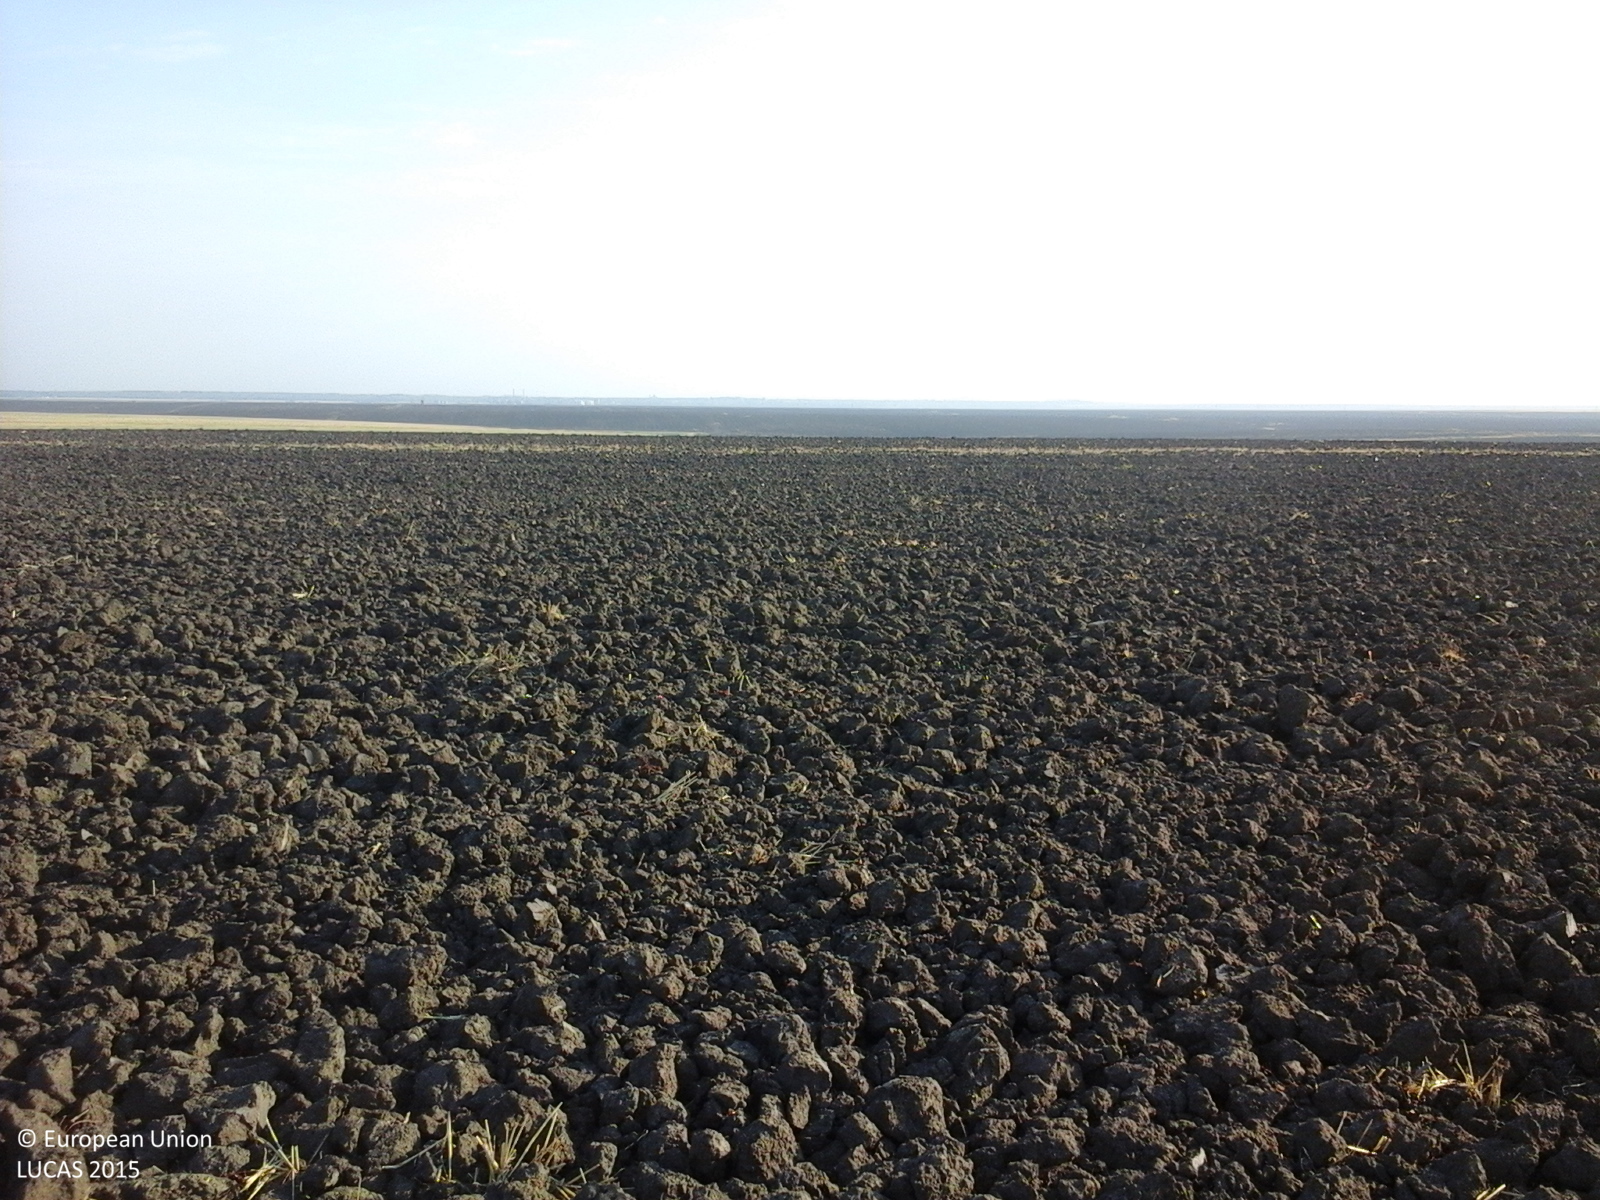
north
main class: Cropland
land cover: Common wheat
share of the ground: < 10 %
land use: Agriculture (excluding fallow land and kitchen gardens)
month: August
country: RO
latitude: 44.0200
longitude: 23.7129
